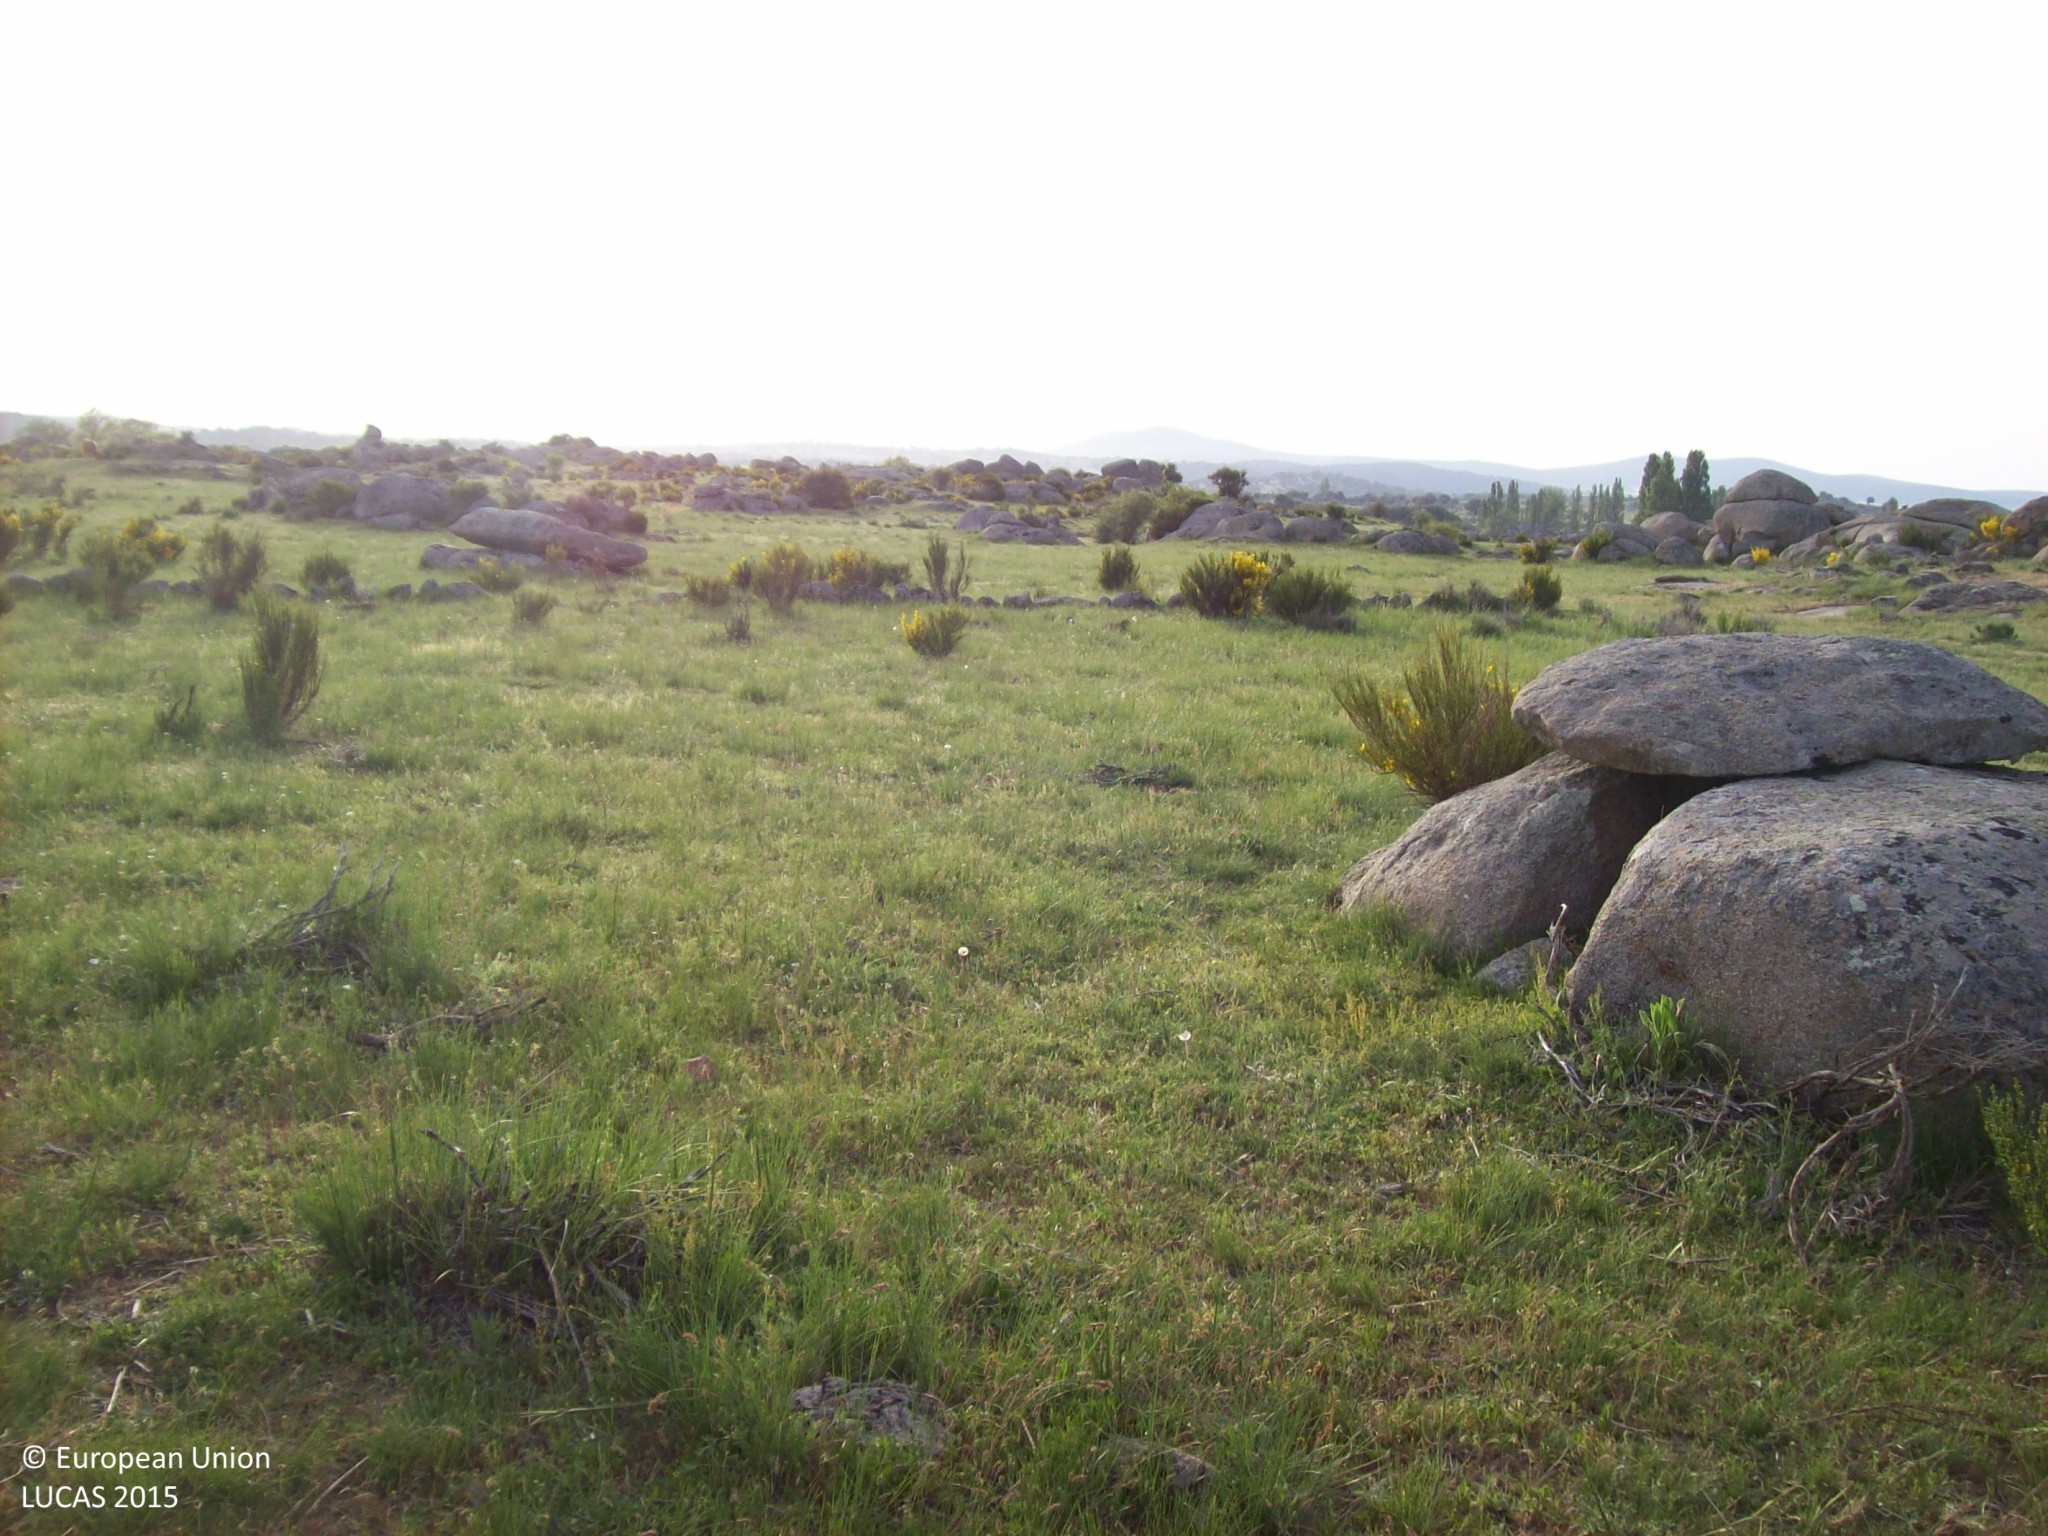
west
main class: Shrubland
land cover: Shrubland without tree cover
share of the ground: 10 - 25 %
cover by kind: consolidated bare surface 40 %, herbaceous plants 35 %, shrubs 20 %
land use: Agriculture (excluding fallow land and kitchen gardens)
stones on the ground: < 10 %
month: May
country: ES
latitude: 40.6992
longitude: -4.9124
